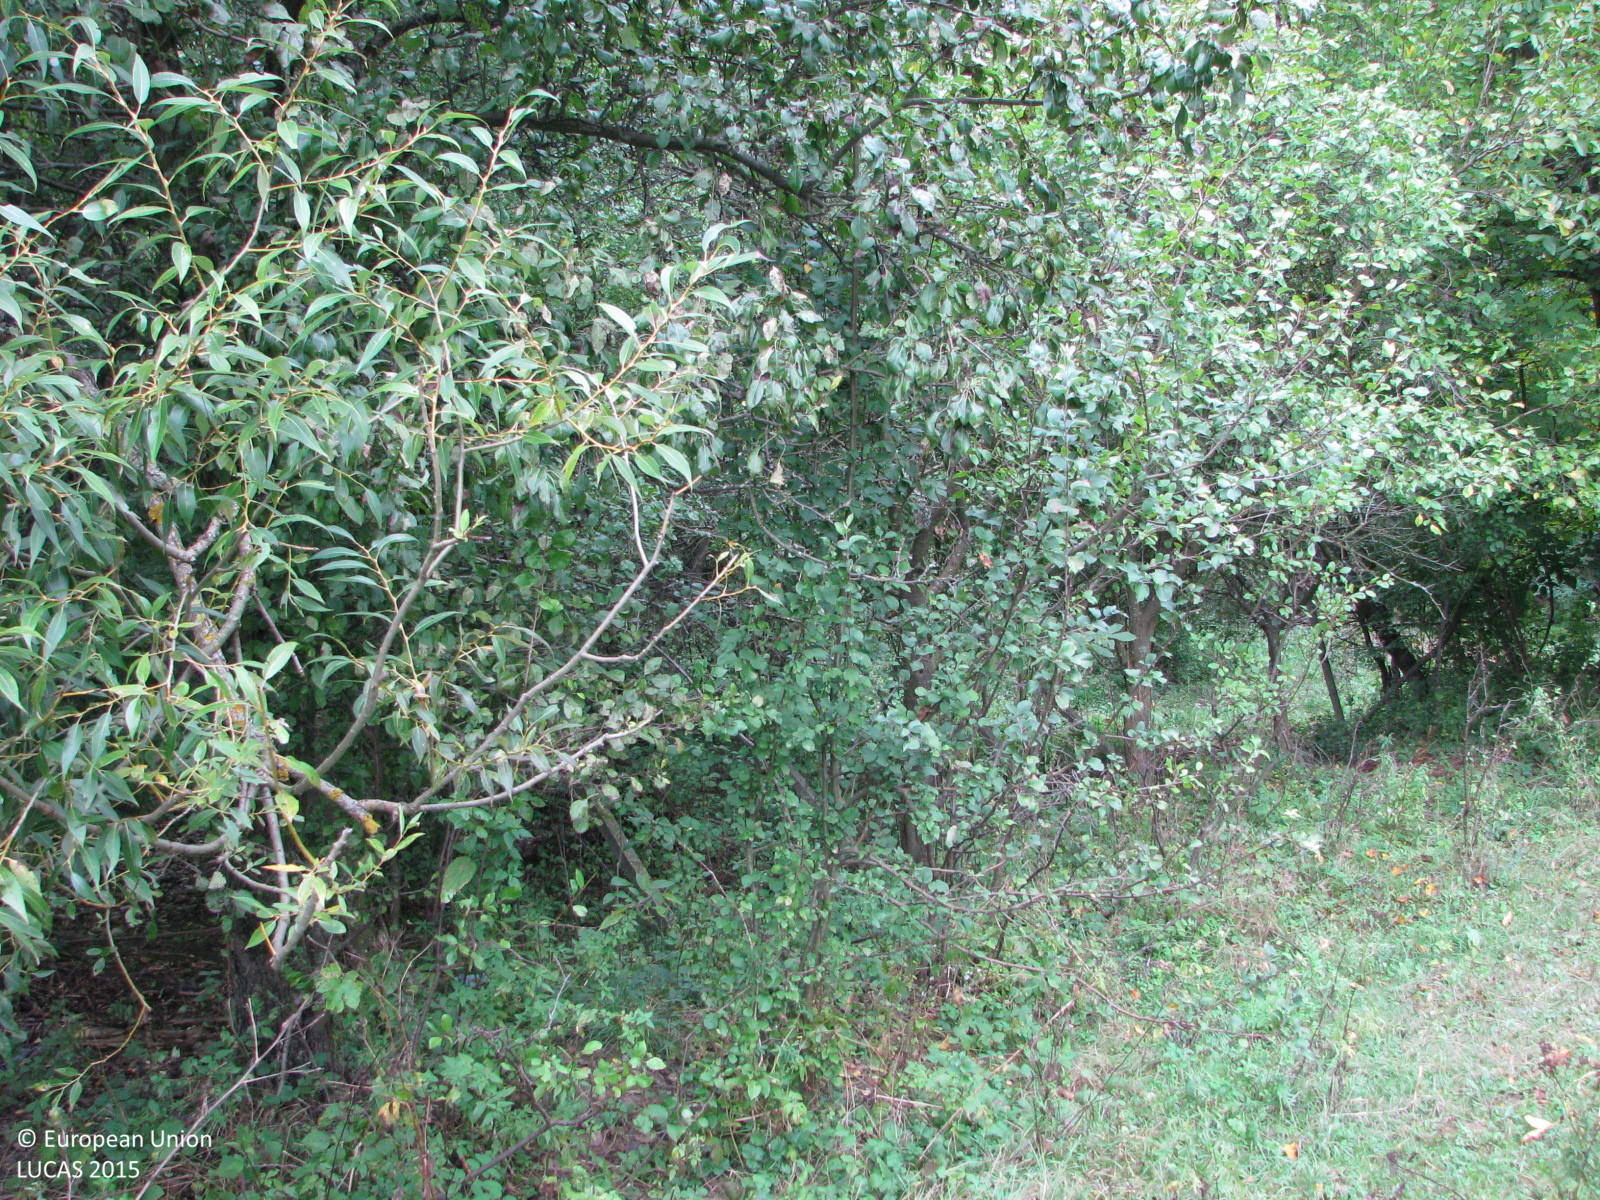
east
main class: Grassland
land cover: Grassland without tree/shrub cover
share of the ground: > 75 %
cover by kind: herbaceous plants 100 %
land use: Agriculture (excluding fallow land and kitchen gardens)
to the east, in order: Grassland without tree/shrub cover; Grassland with sparse tree/shrub cover; Fences; Broadleaved woodland; Tracks; Broadleaved woodland
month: September
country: BG
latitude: 42.7680
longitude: 26.4585
